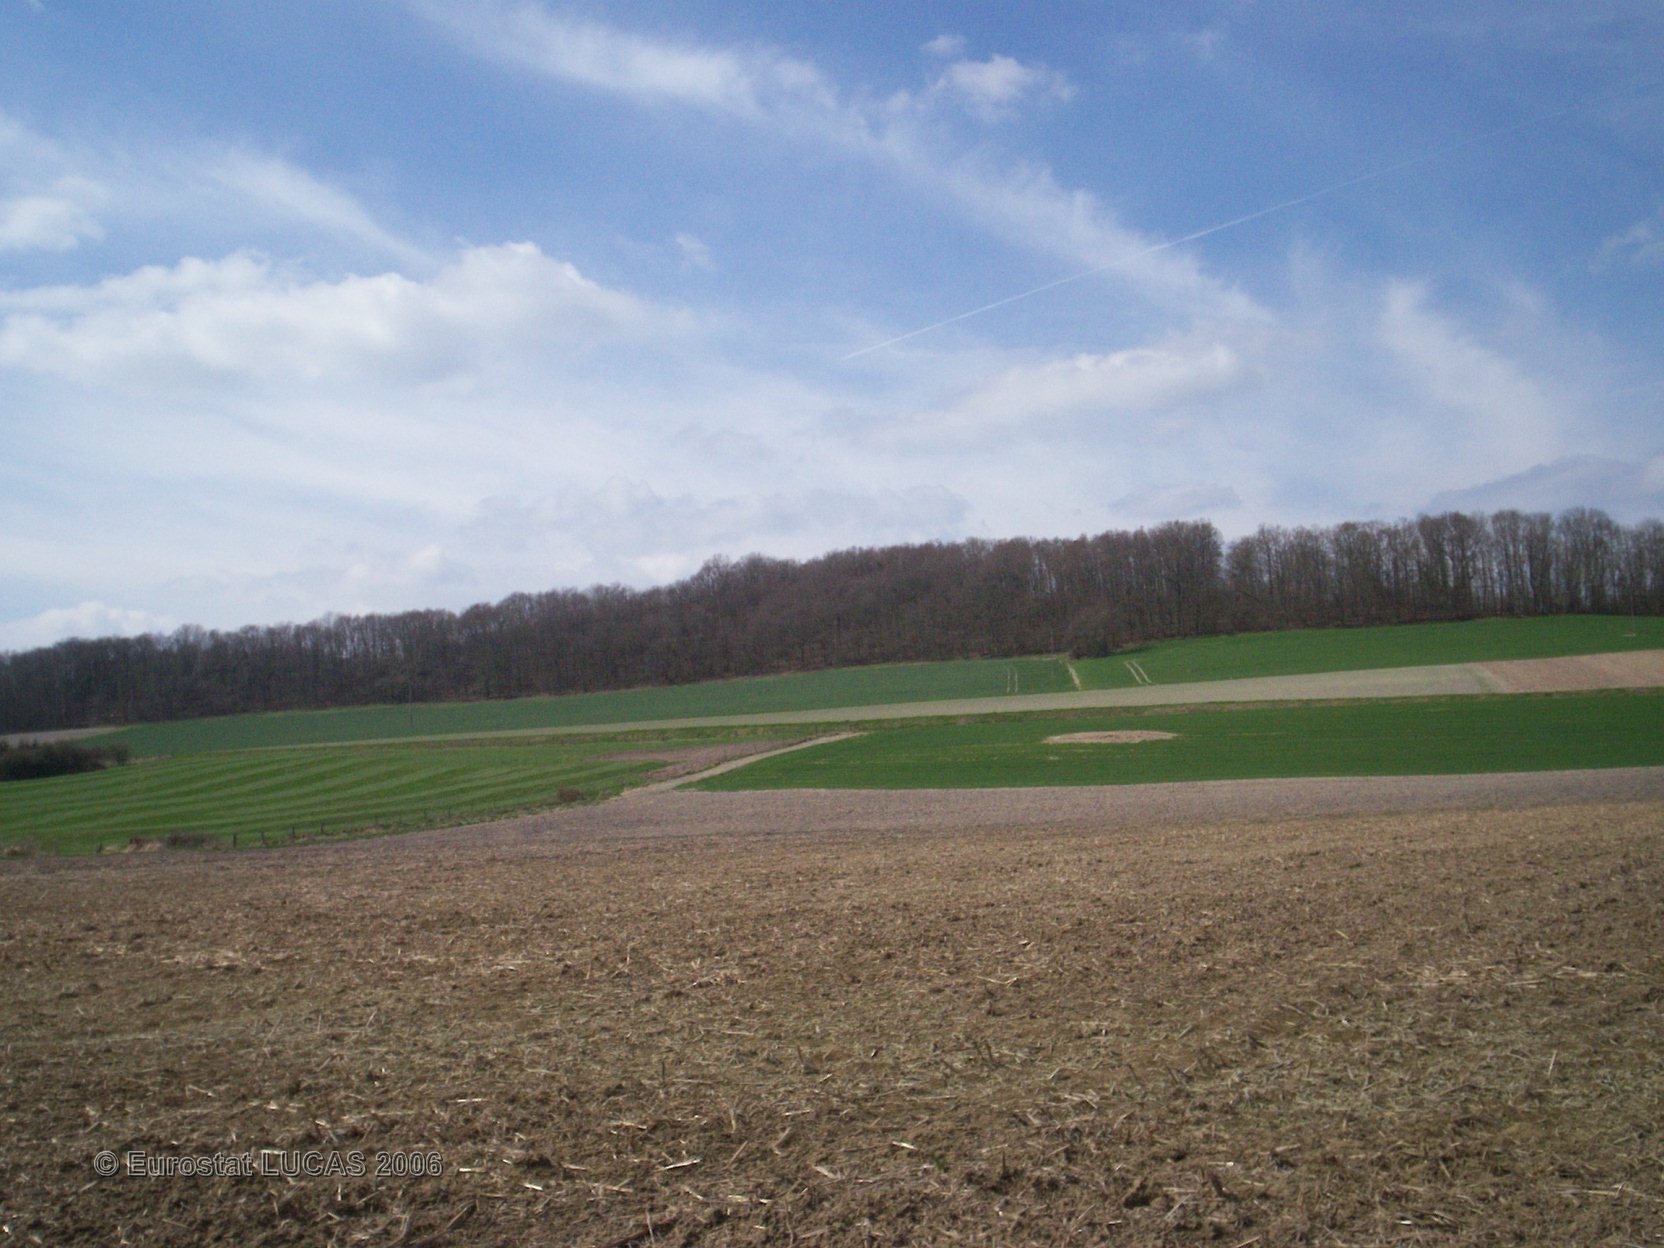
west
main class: Cropland
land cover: Maize
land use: Agriculture (excluding fallow land and kitchen gardens)
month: May
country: FR
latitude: 49.3285
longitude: 4.8373
